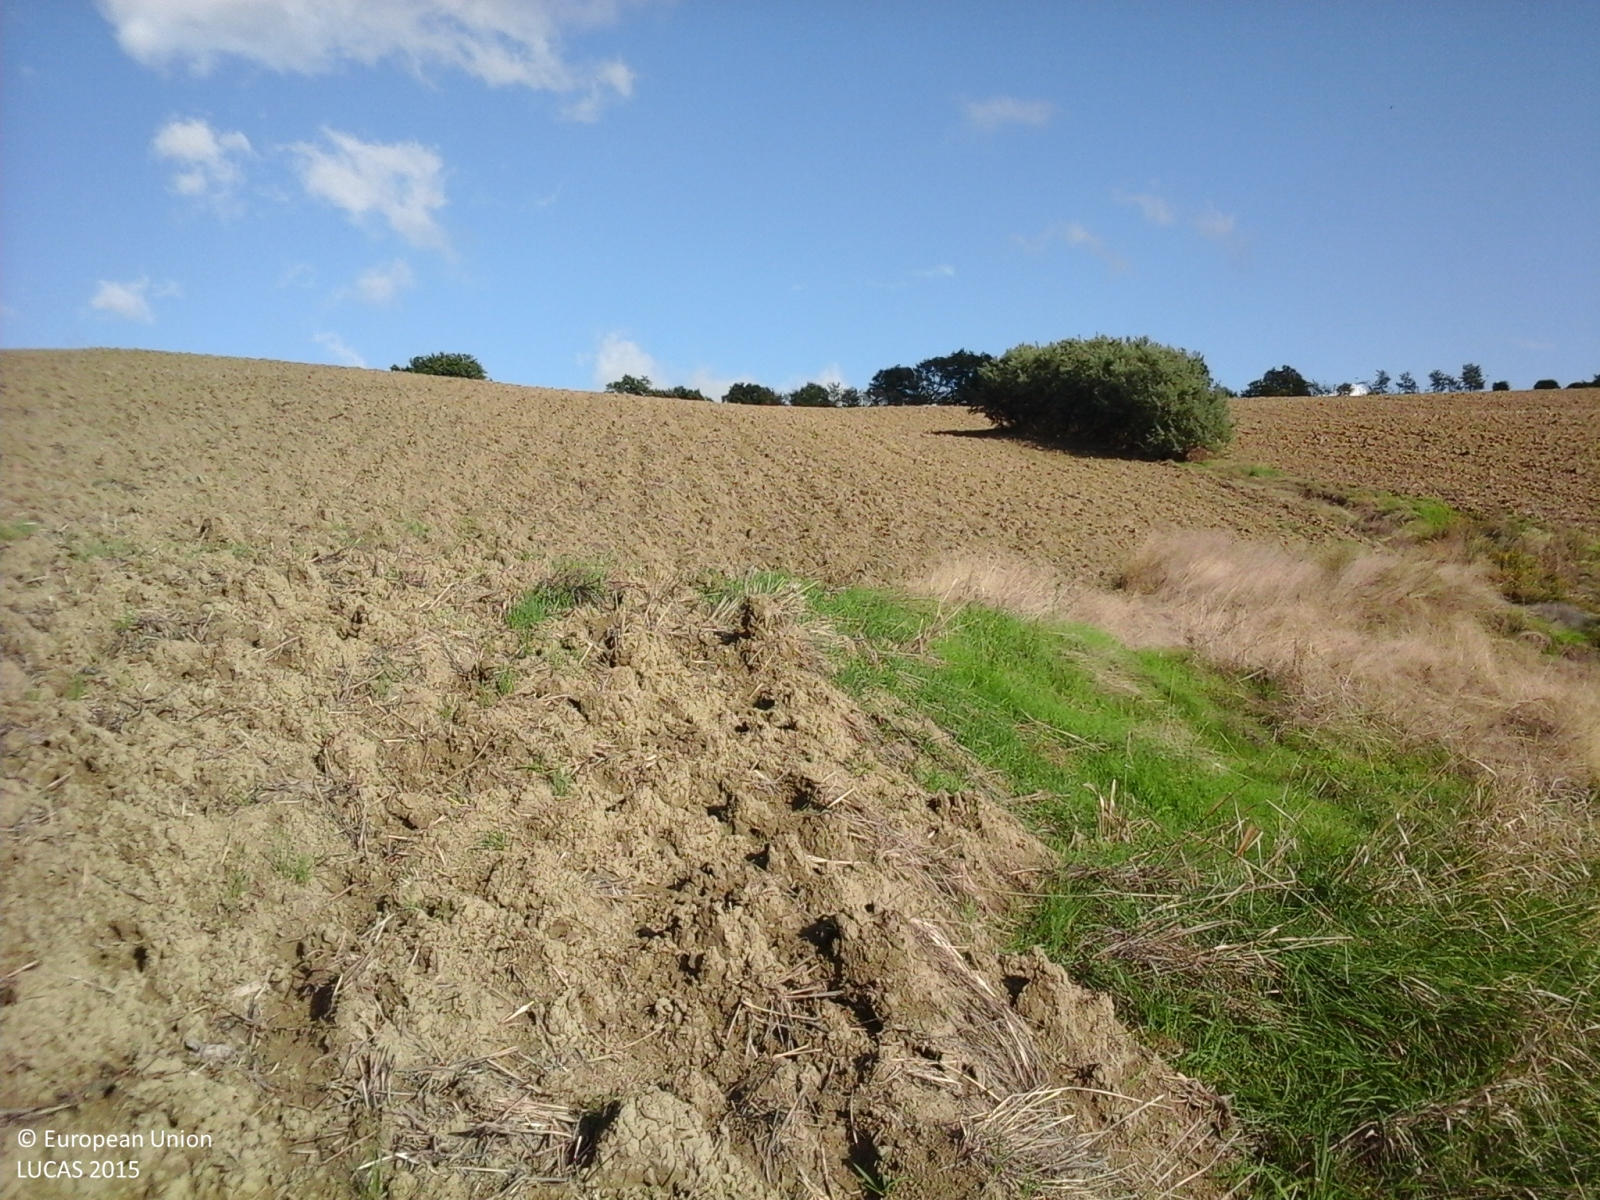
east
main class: Cropland
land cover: Durum wheat
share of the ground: < 10 %
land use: Agriculture (excluding fallow land and kitchen gardens)
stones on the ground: < 10 %
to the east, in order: Durum wheat; Grassland without tree/shrub cover; Durum wheat
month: October
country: IT
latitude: 43.5367
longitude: 13.3949
